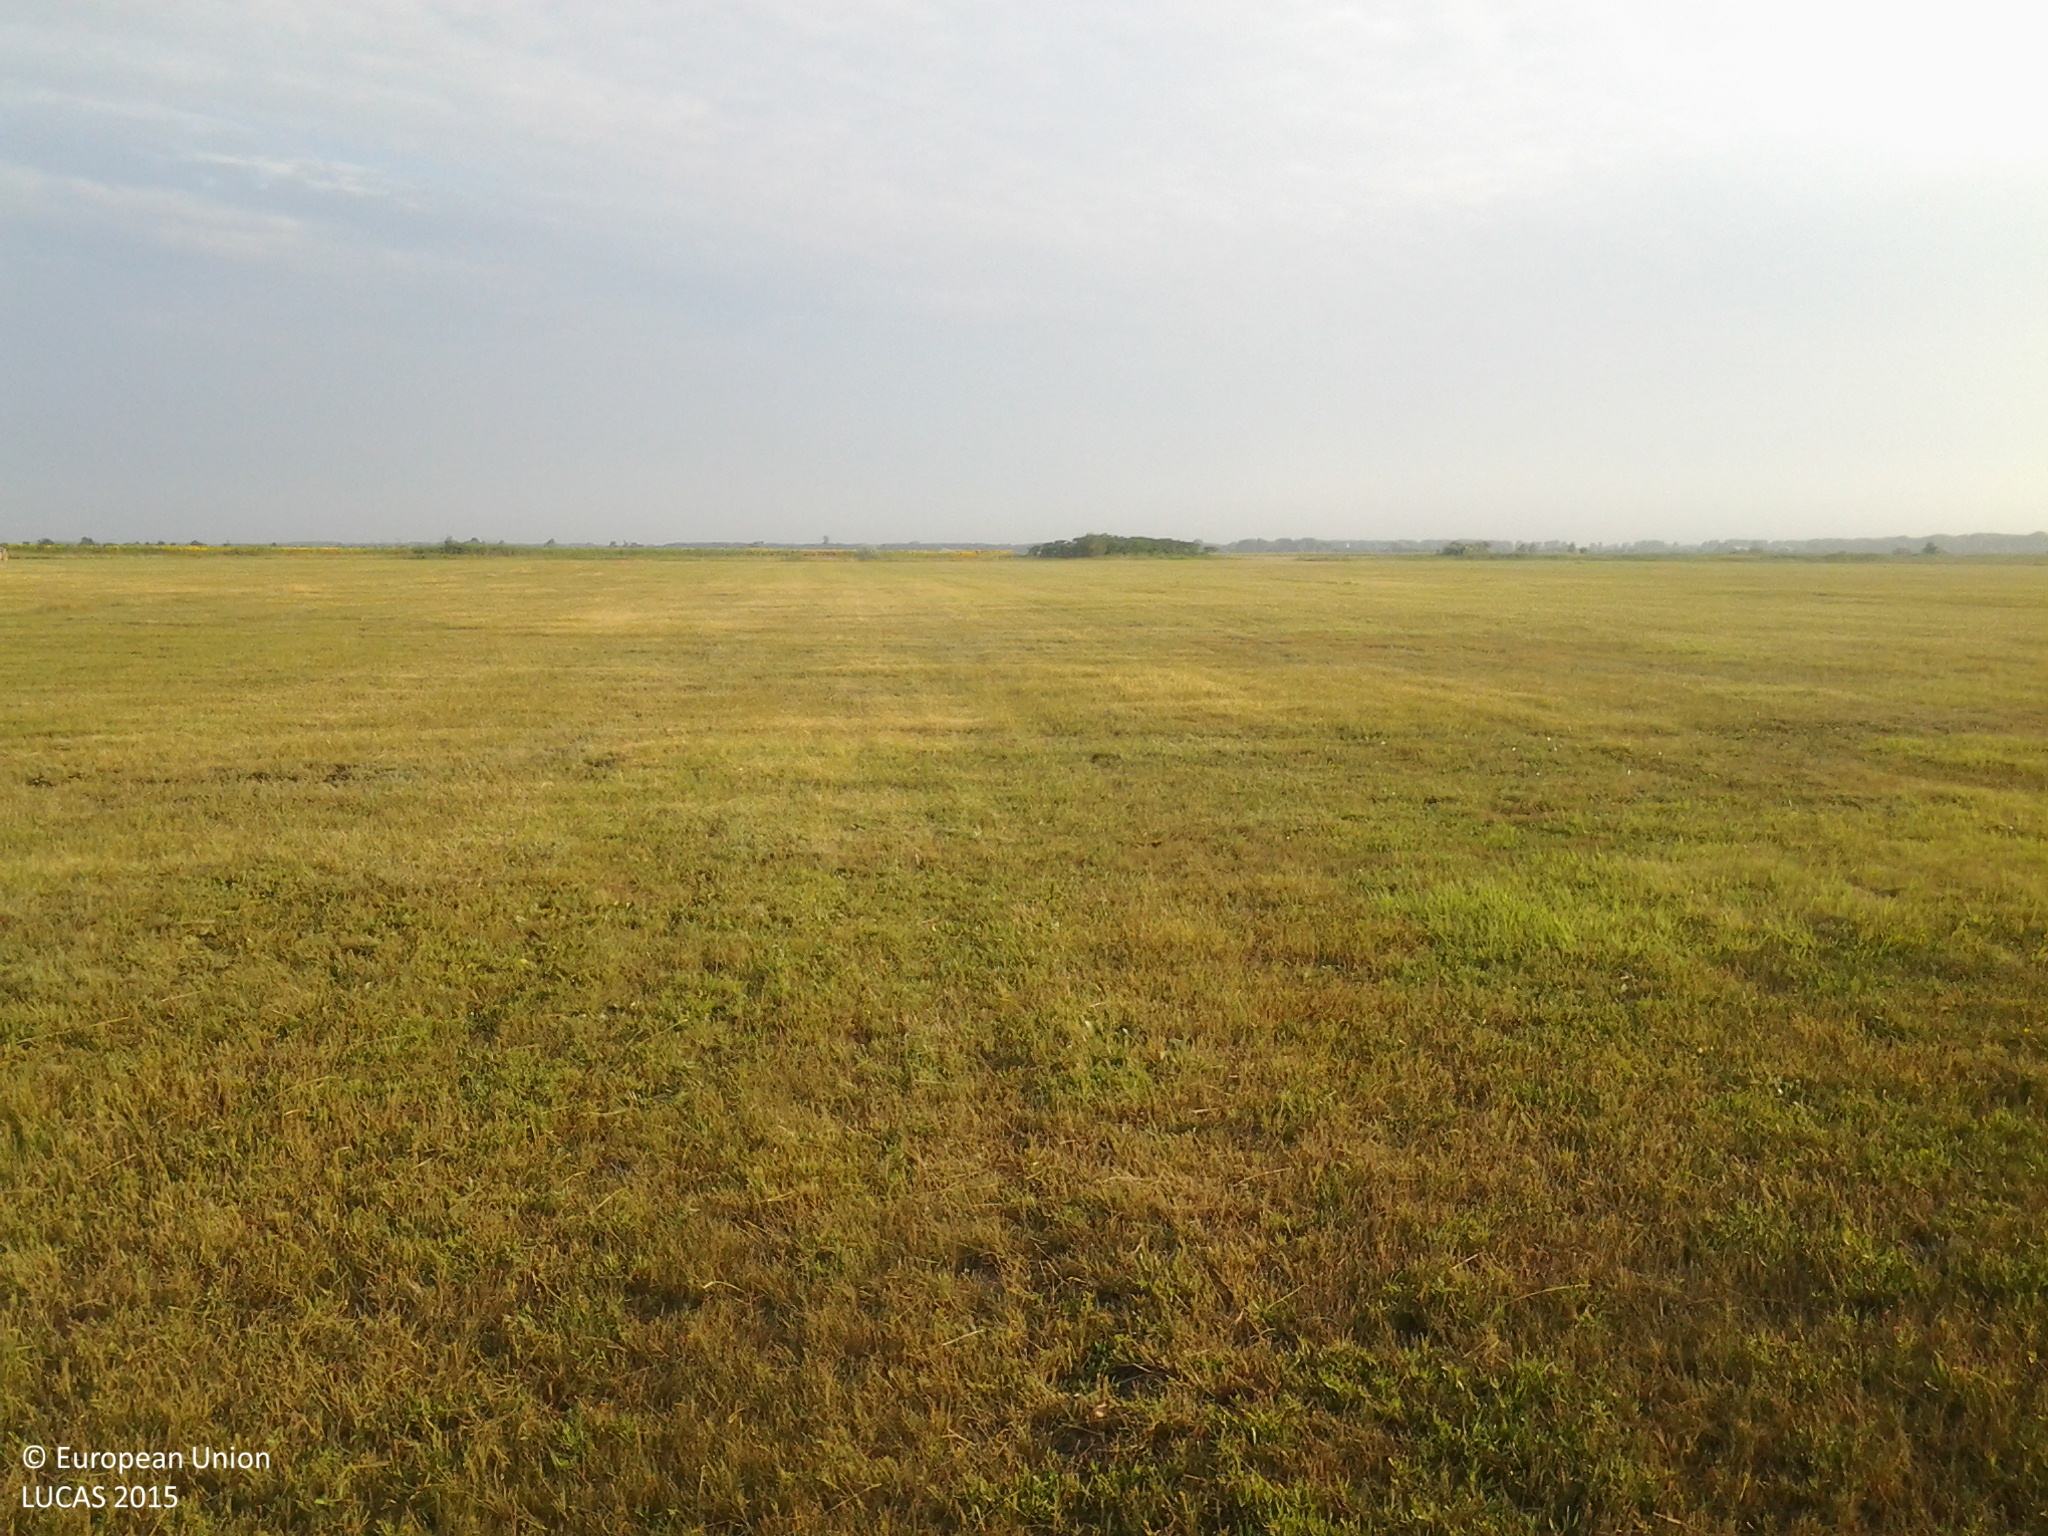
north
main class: Grassland
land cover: Grassland without tree/shrub cover
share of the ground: 50 - 75 %
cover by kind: herbaceous plants 100 %
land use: Agriculture (excluding fallow land and kitchen gardens)
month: July
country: HU
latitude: 46.8858
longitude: 19.1104
